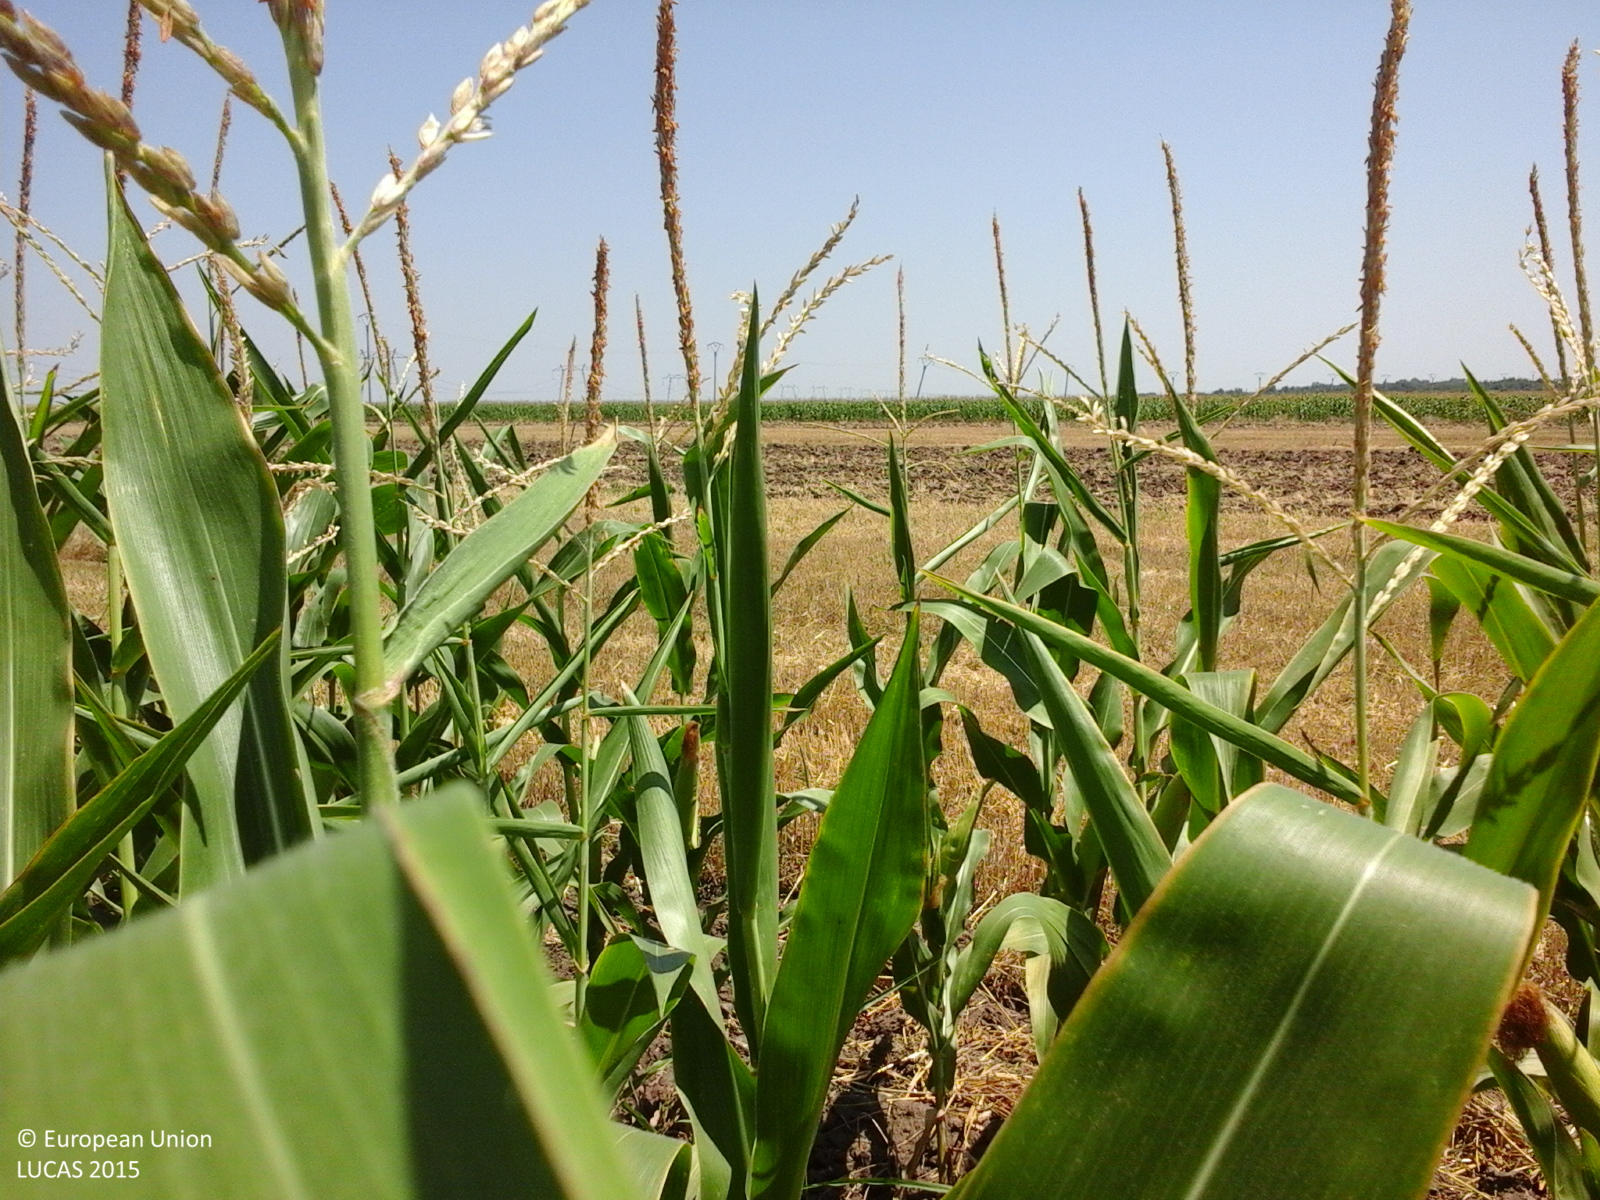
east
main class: Cropland
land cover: Maize
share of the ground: > 75 %
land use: Agriculture (excluding fallow land and kitchen gardens)
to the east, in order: Maize; Common wheat; Maize
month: July
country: RO
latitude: 44.2037
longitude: 27.0069
